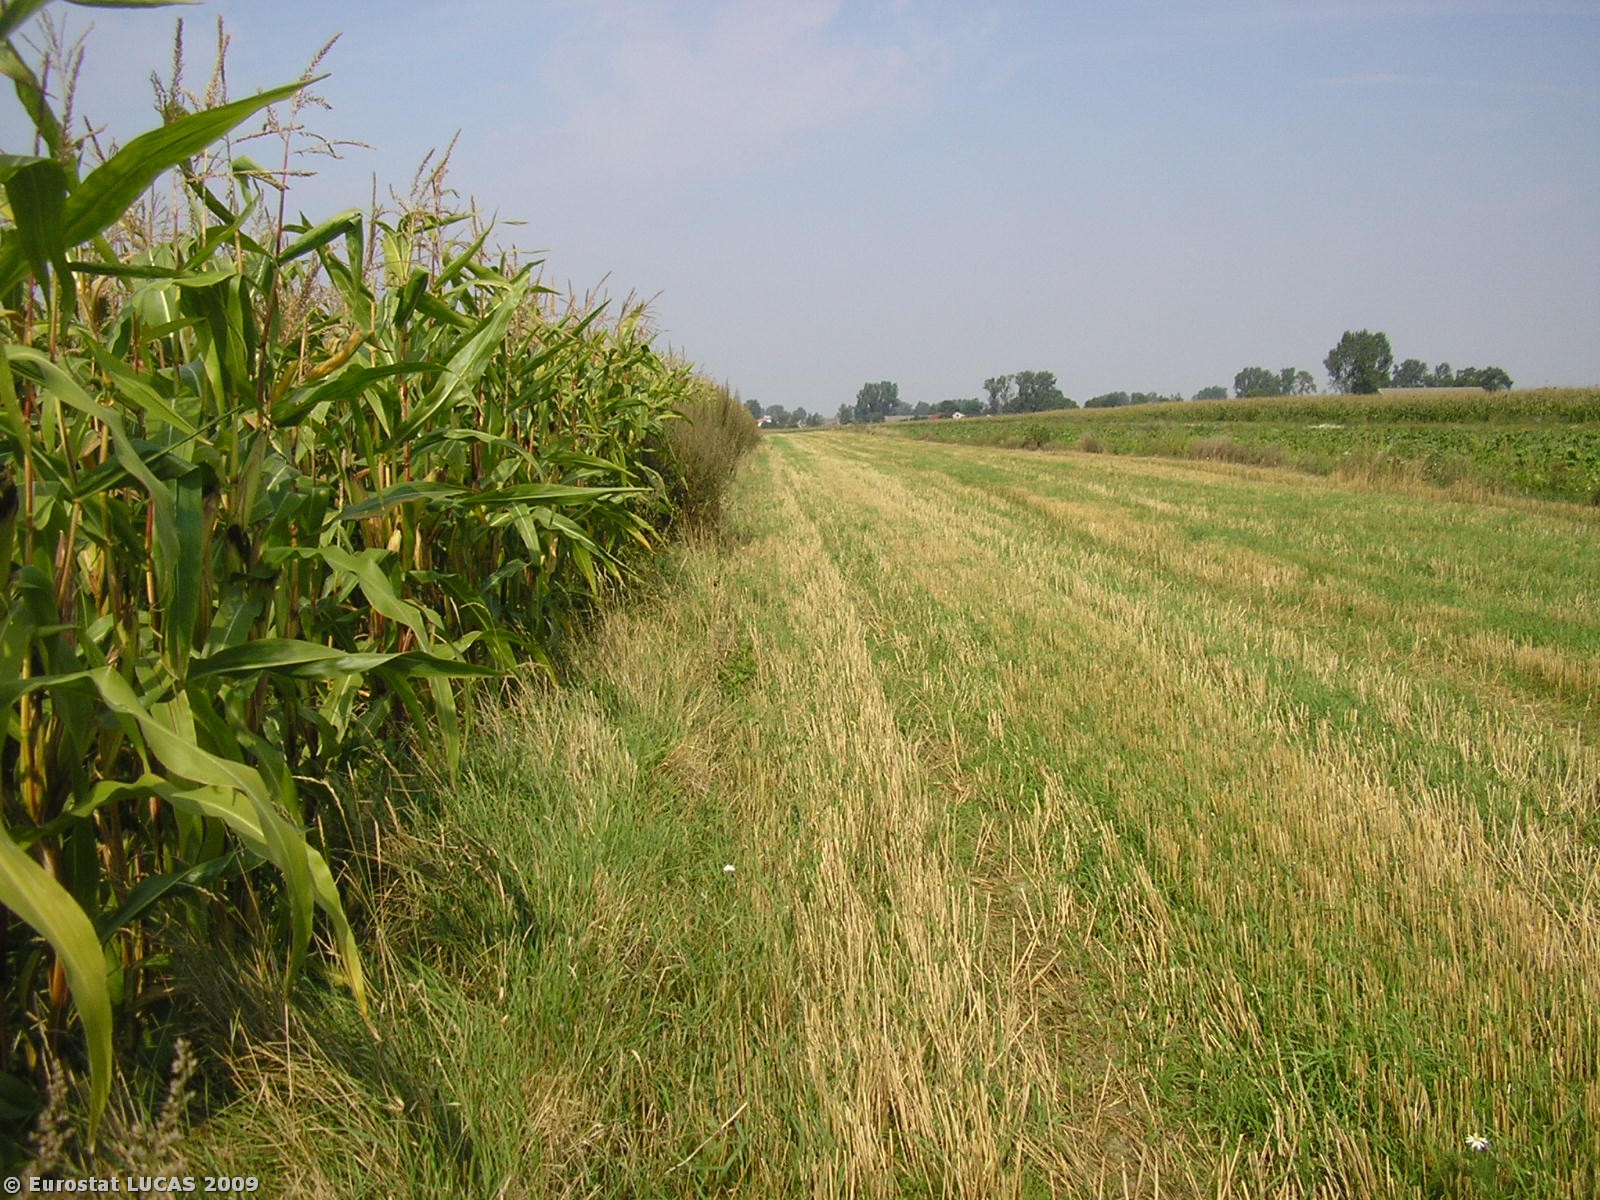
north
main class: Cropland
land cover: Maize
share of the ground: > 75 %
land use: Agriculture (excluding fallow land and kitchen gardens)
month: September
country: PL
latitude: 52.1326
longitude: 19.5976
